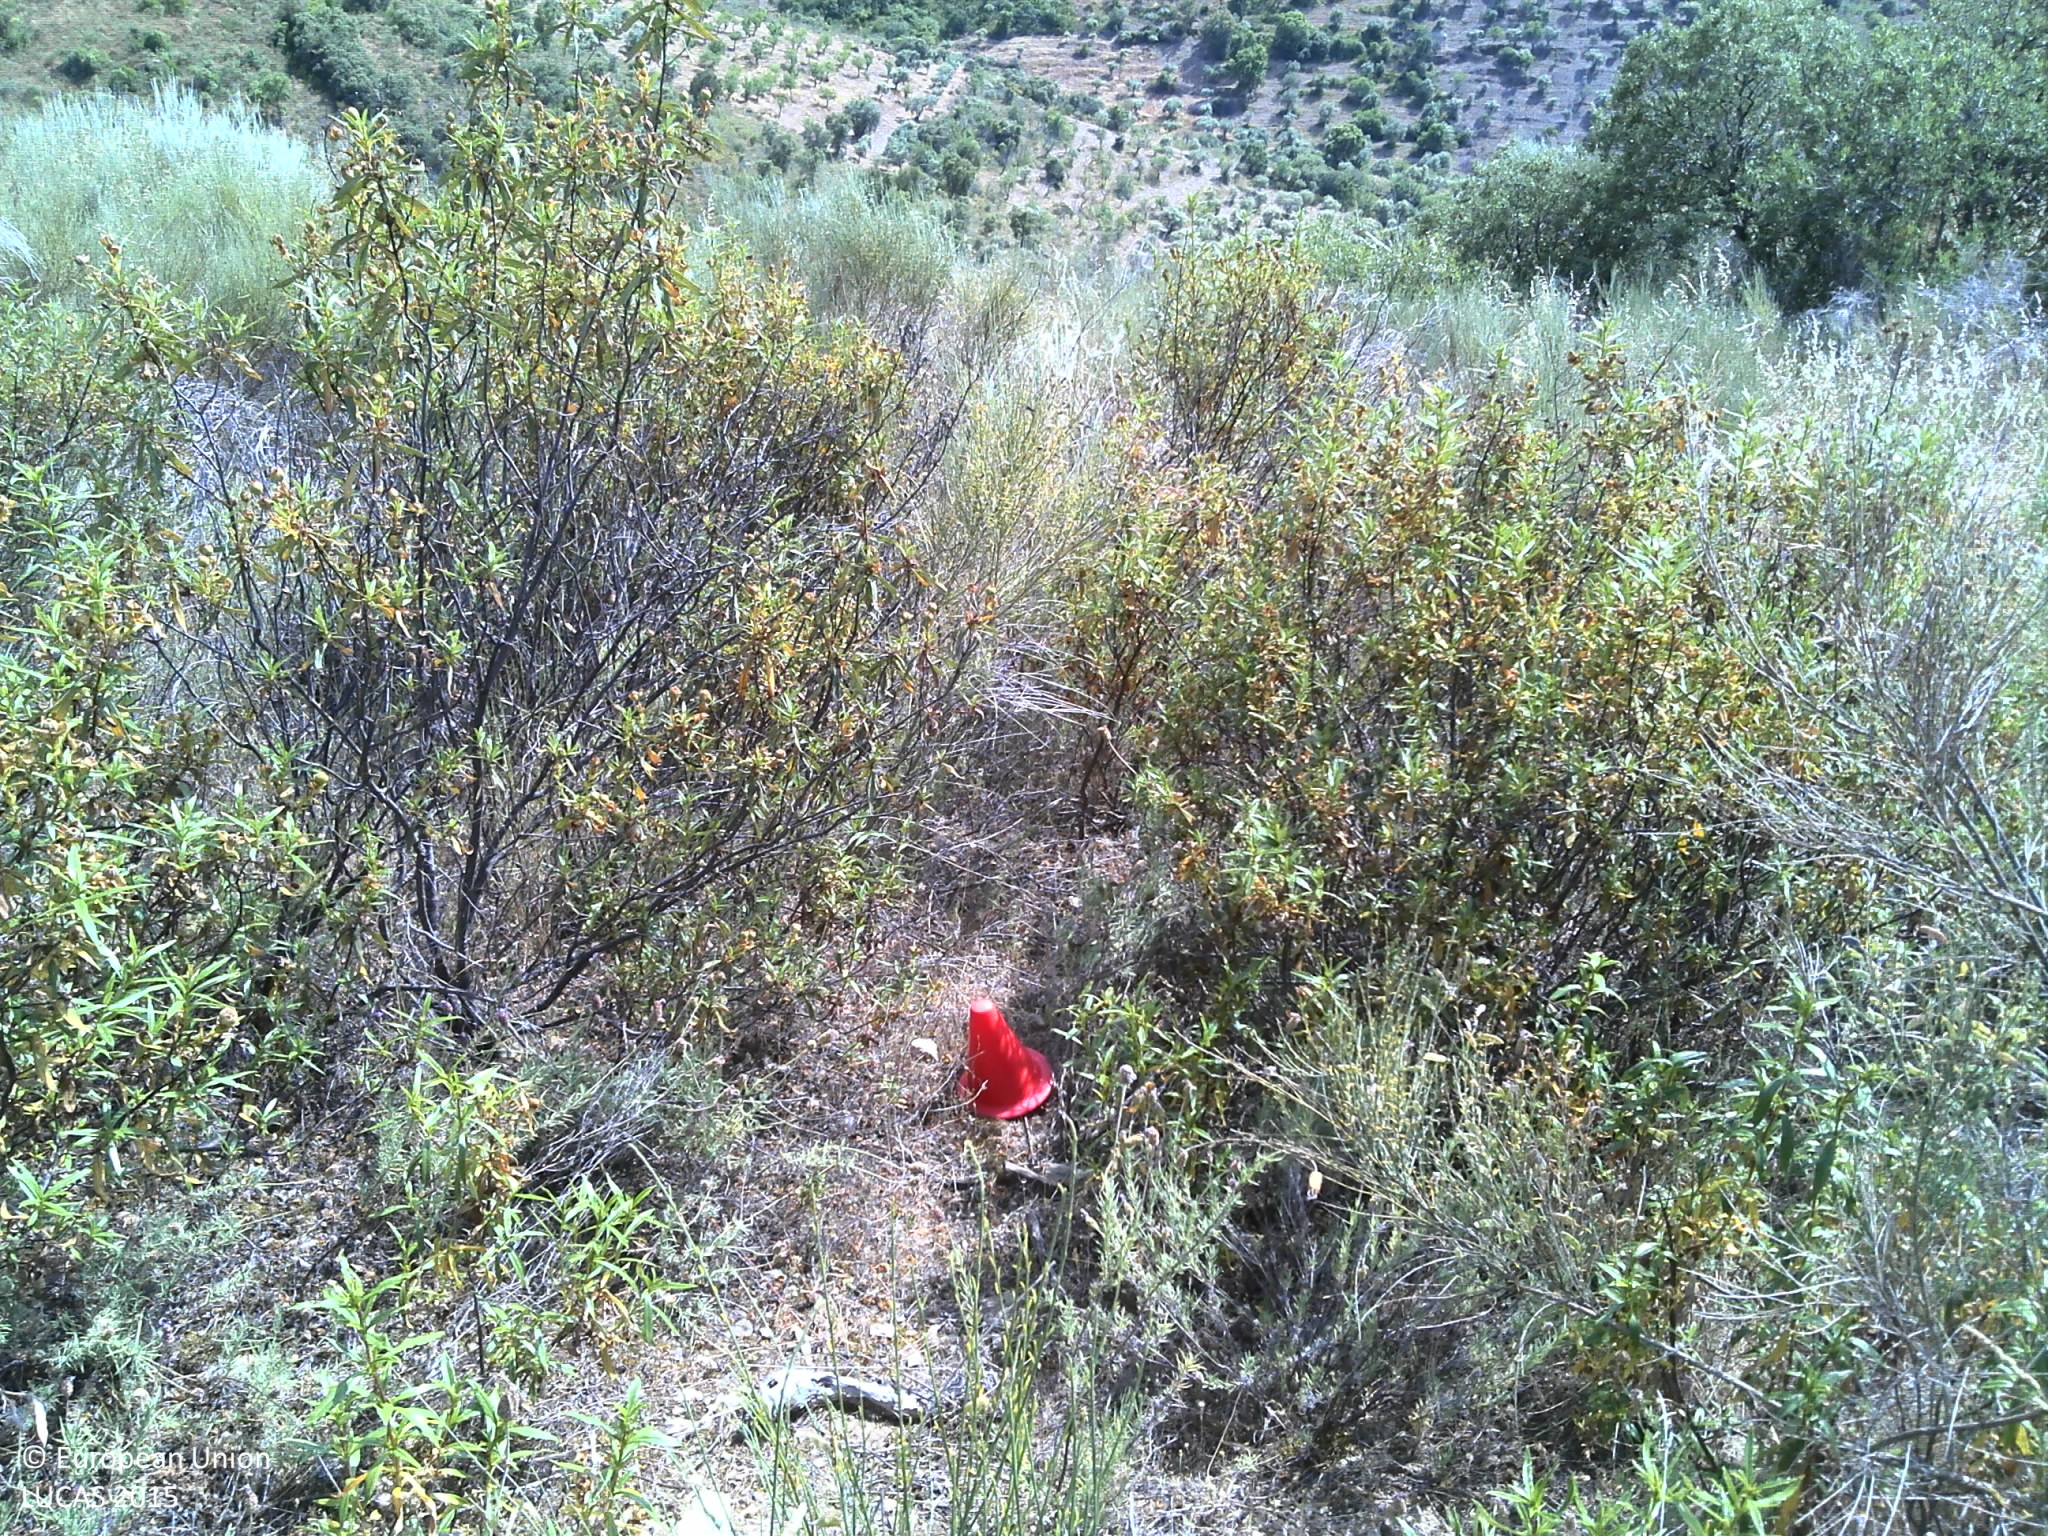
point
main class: Shrubland
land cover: Shrubland with sparse tree cover
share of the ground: 50 - 75 %
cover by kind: shrubs 75 %, unconsolidated bare surface 15 %, broadleaved forest trees 5 %, herbaceous plants 5 %
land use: Abandoned areas
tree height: < 5 m
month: May
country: PT
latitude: 41.2327
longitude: -6.9431
